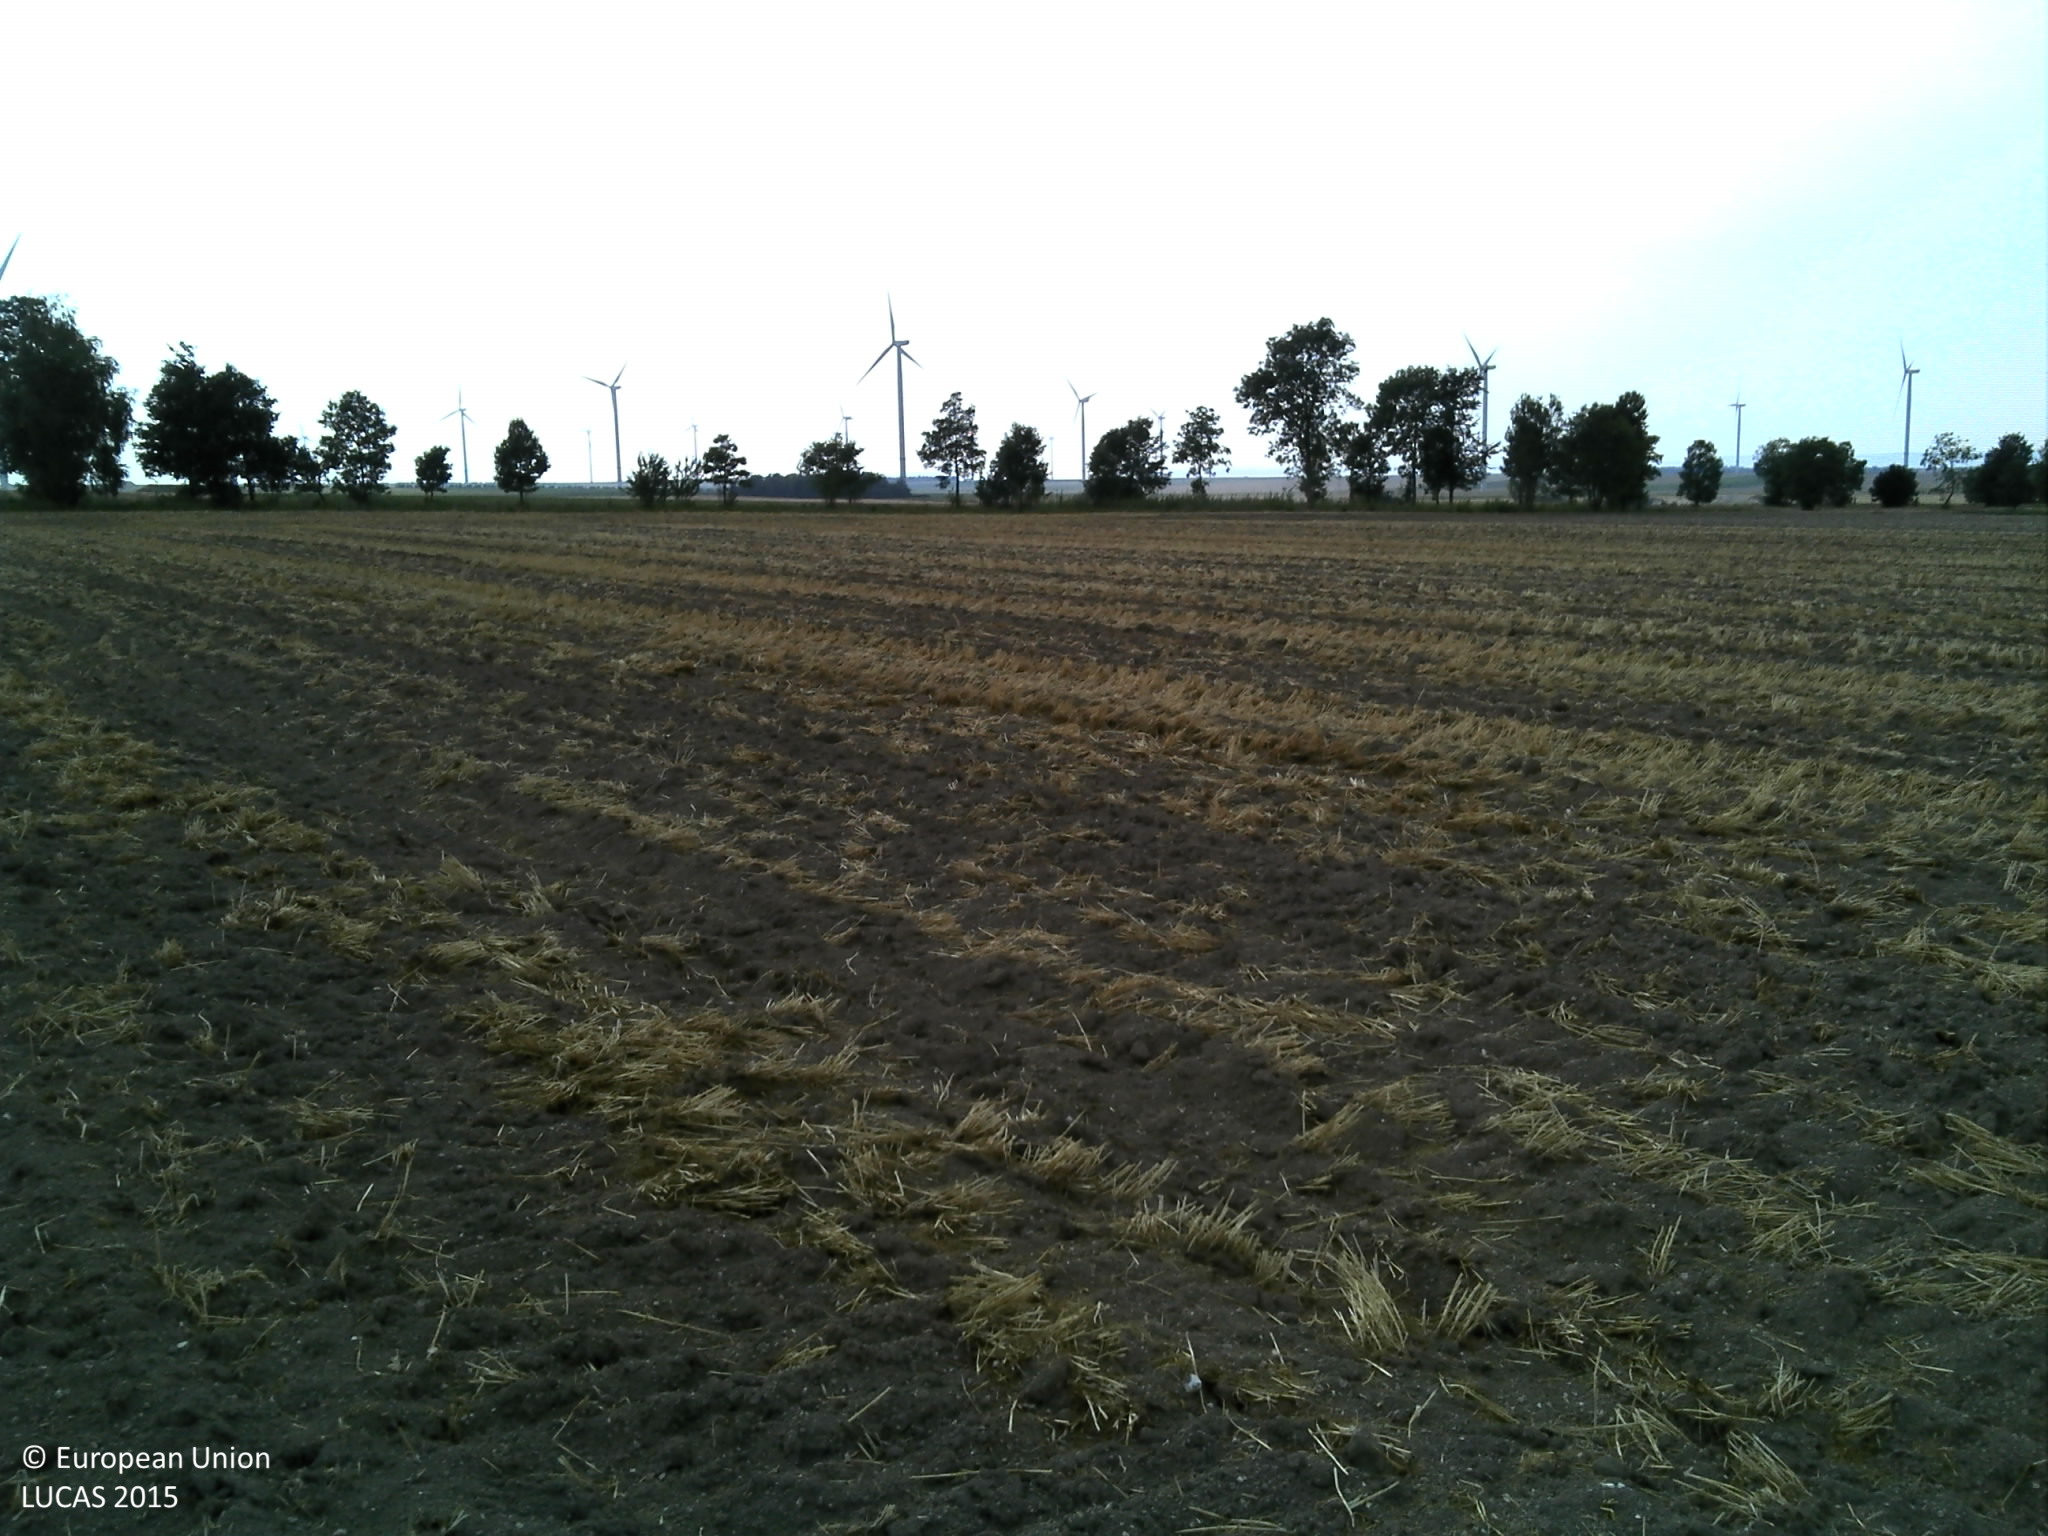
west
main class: Cropland
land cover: Barley
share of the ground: > 75 %
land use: Agriculture (excluding fallow land and kitchen gardens)
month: August
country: FR
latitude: 48.9019
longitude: 4.2254
